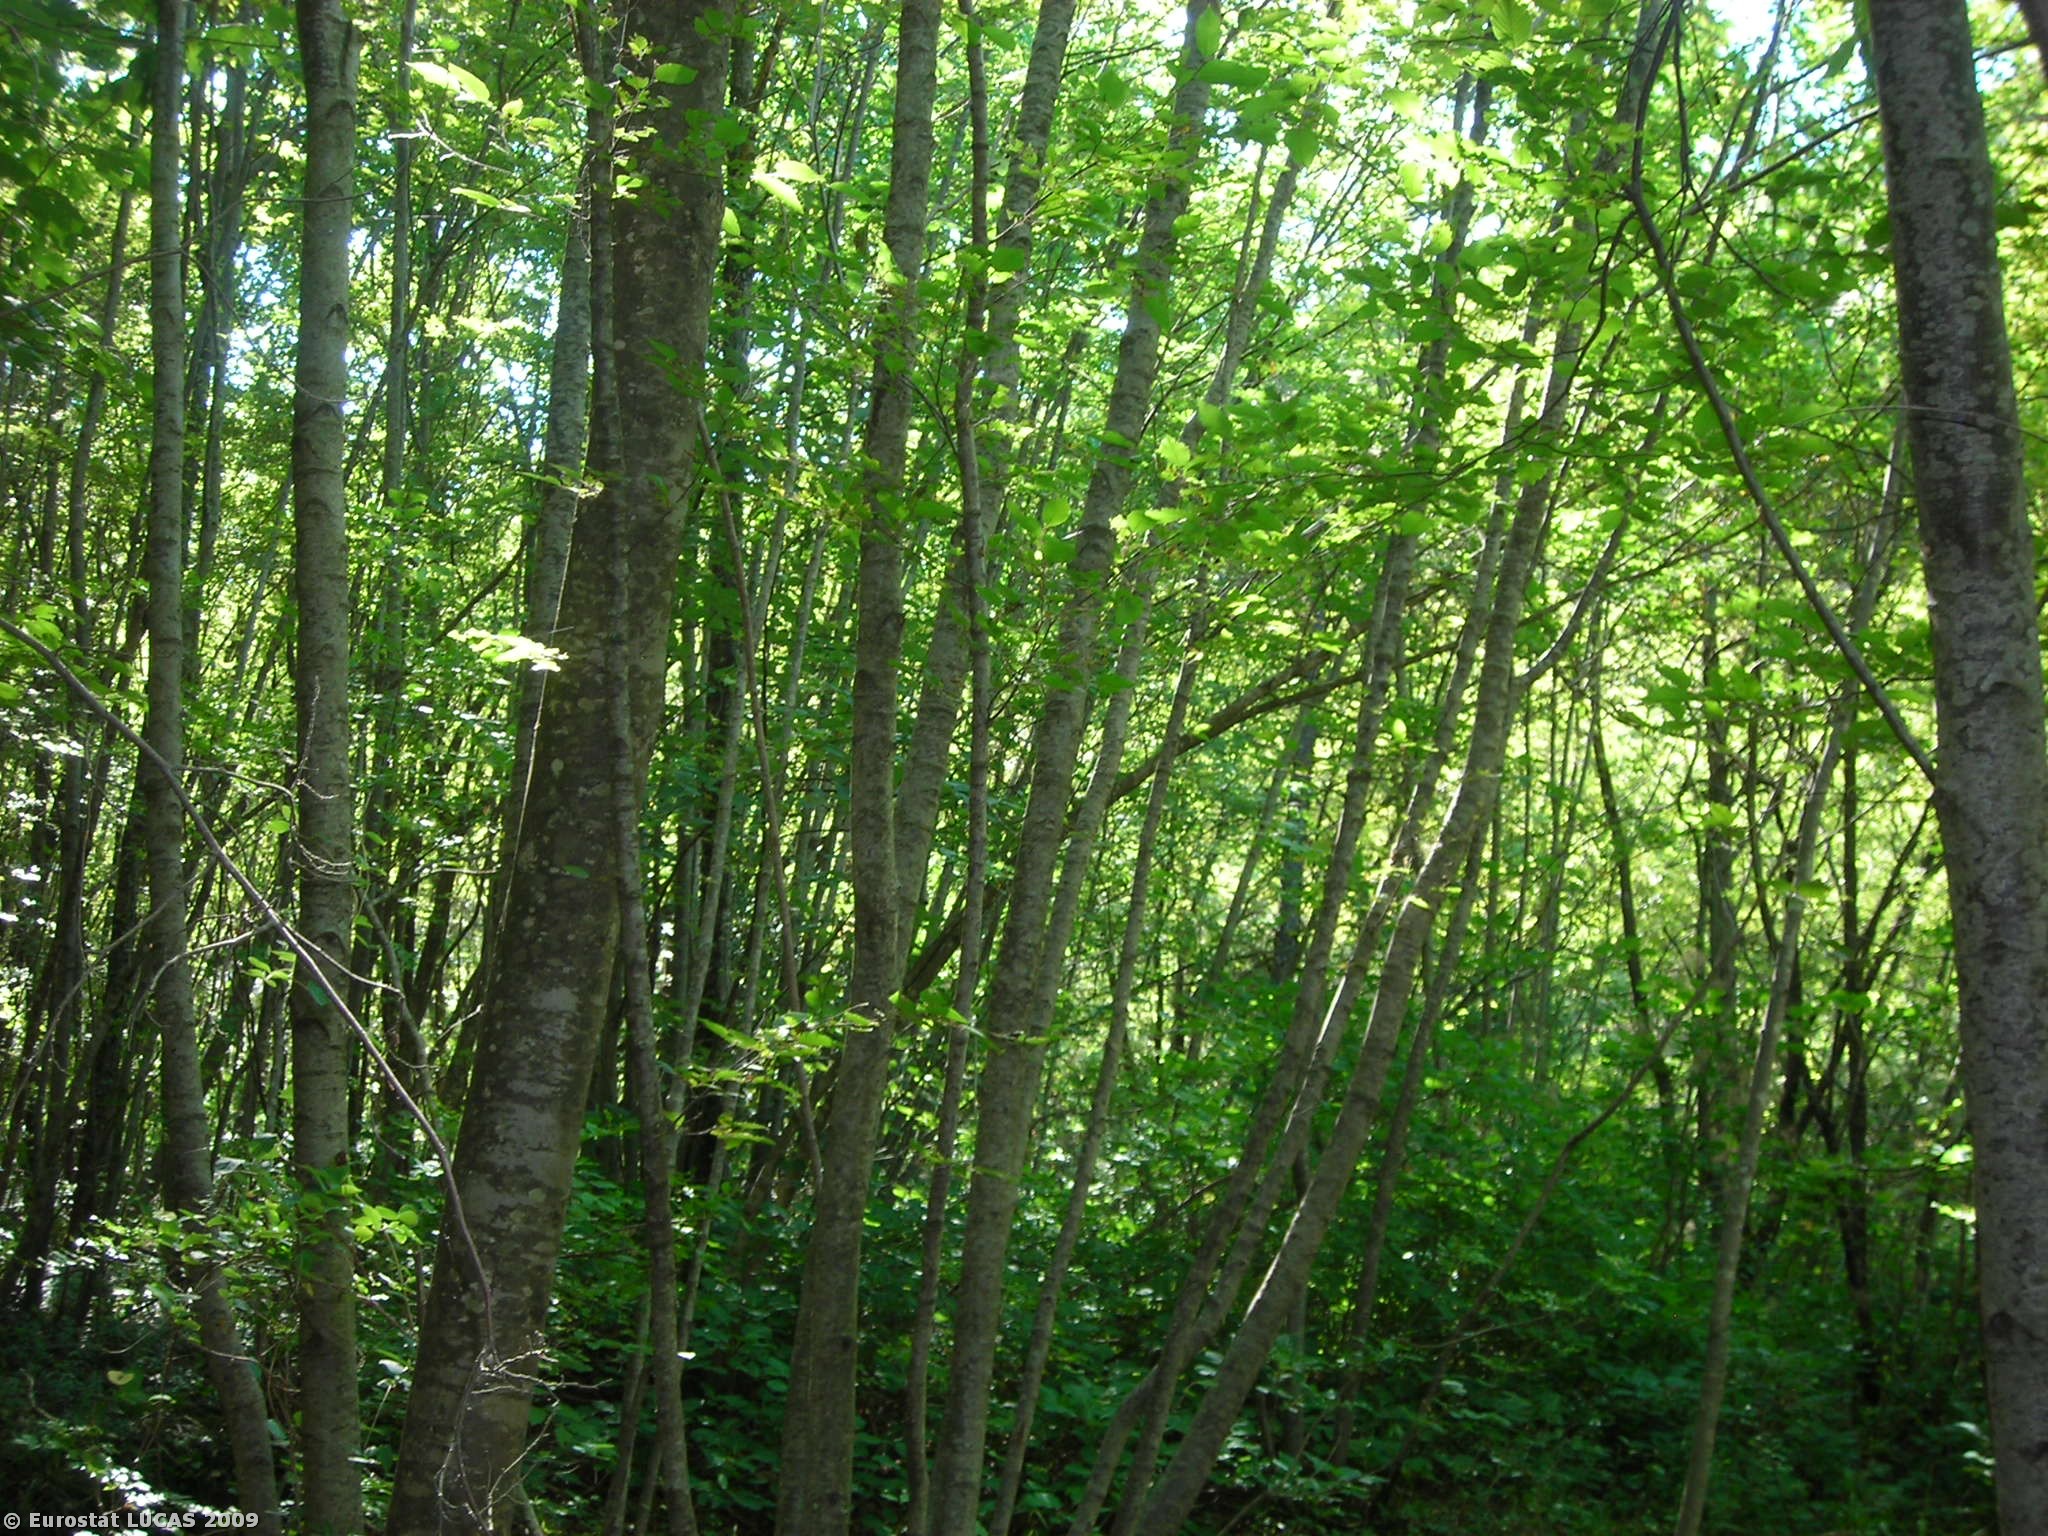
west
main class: Woodland
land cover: Broadleaved woodland
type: thermophilous deciduous forest
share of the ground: > 75 %
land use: Forestry
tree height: > 5 m
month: July
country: IT
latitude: 43.3071
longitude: 13.2339
